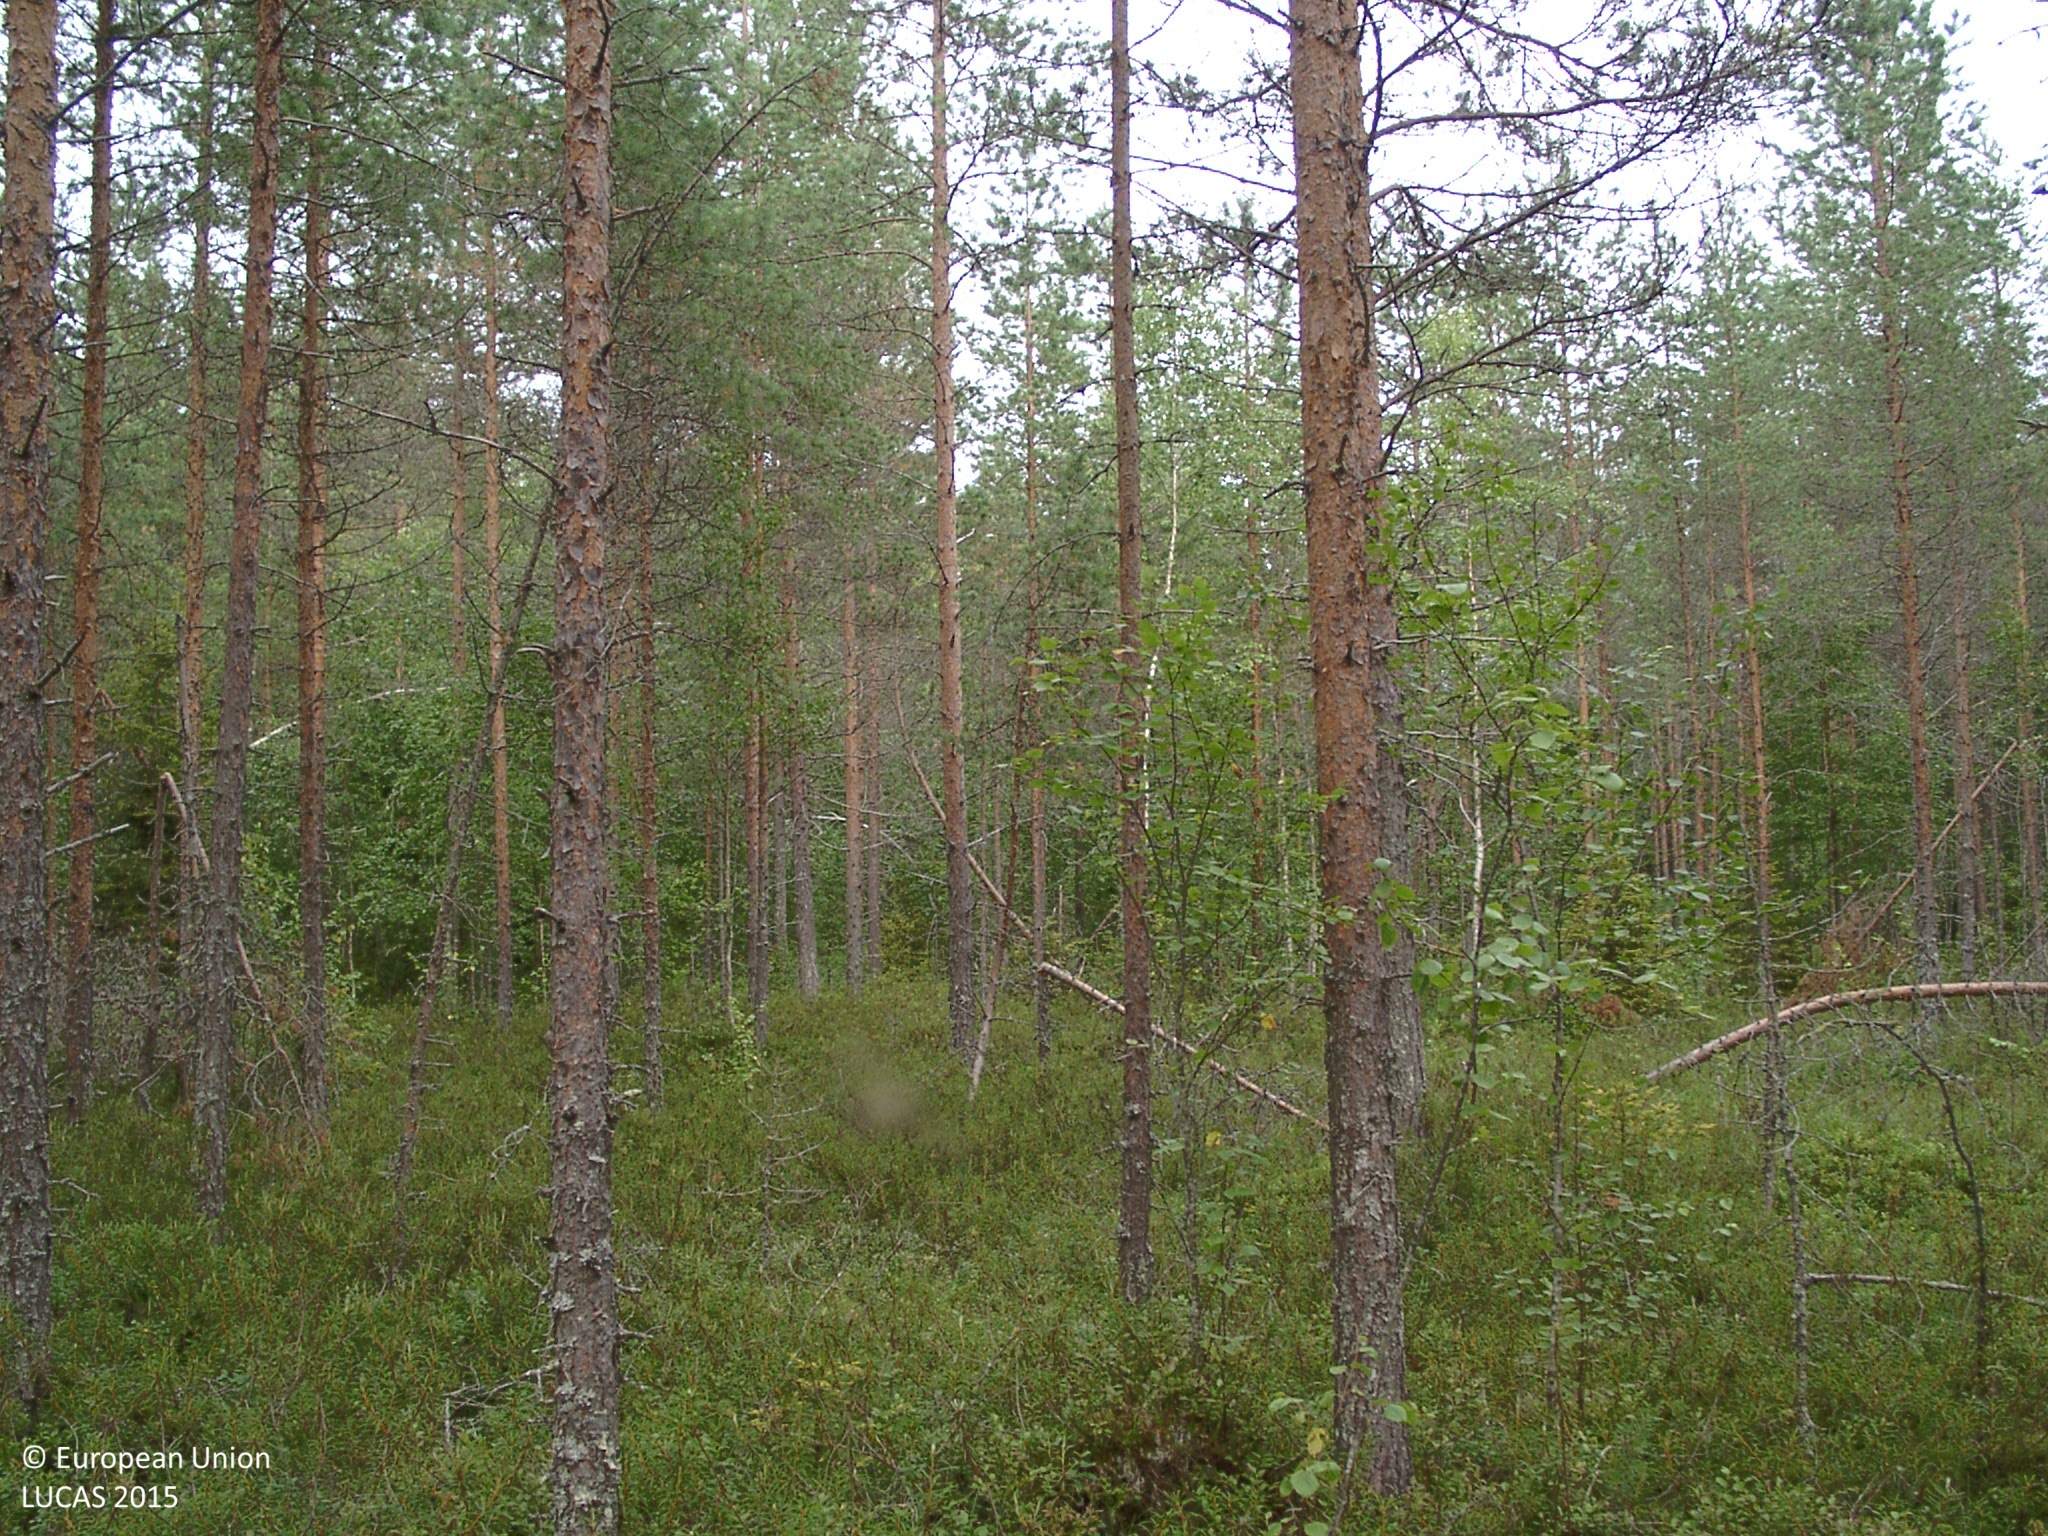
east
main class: Woodland
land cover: Pine dominated coniferous woodland
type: mire and swamp forests
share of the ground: 50 - 75 %
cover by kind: coniferous forest trees 55 %, shrubs 30 %, lichens and mosses 10 %, broadleaved forest trees 5 %
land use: Forestry
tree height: > 5 m
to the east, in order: Pine dominated coniferous woodland; Ditches and canals; Pine dominated mixed woodland; Ditches and canals; Other mixed woodland; Shruby margins; Other mixed woodland; Shruby margins; Other coniferous woodland; Shruby margins; Other mixed woodland
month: August
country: FI
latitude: 62.9846
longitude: 24.7521
